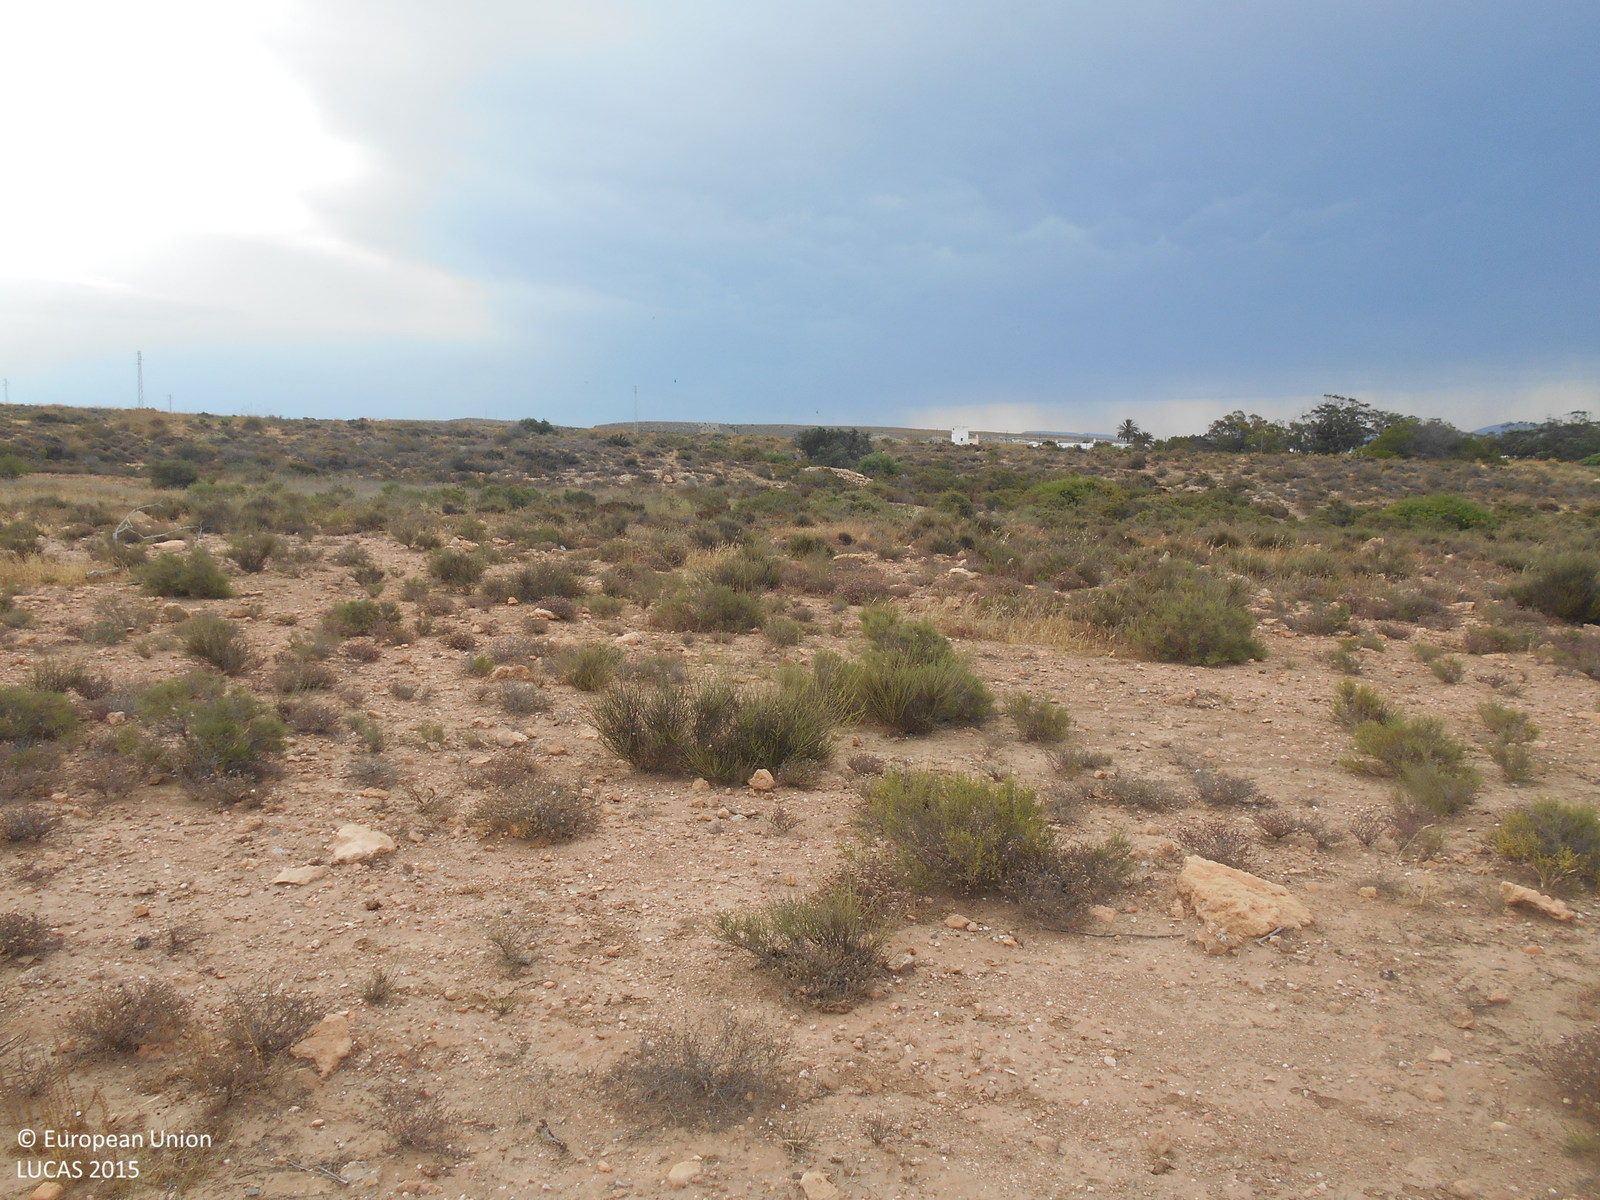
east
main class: Shrubland
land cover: Shrubland without tree cover
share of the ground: 10 - 25 %
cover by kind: unconsolidated bare surface 70 %, shrubs 20 %, herbaceous plants 10 %
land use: Semi-natural and natural areas not in use
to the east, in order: Shrubland without tree cover
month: May
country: ES
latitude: 36.8541
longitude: -2.3004
